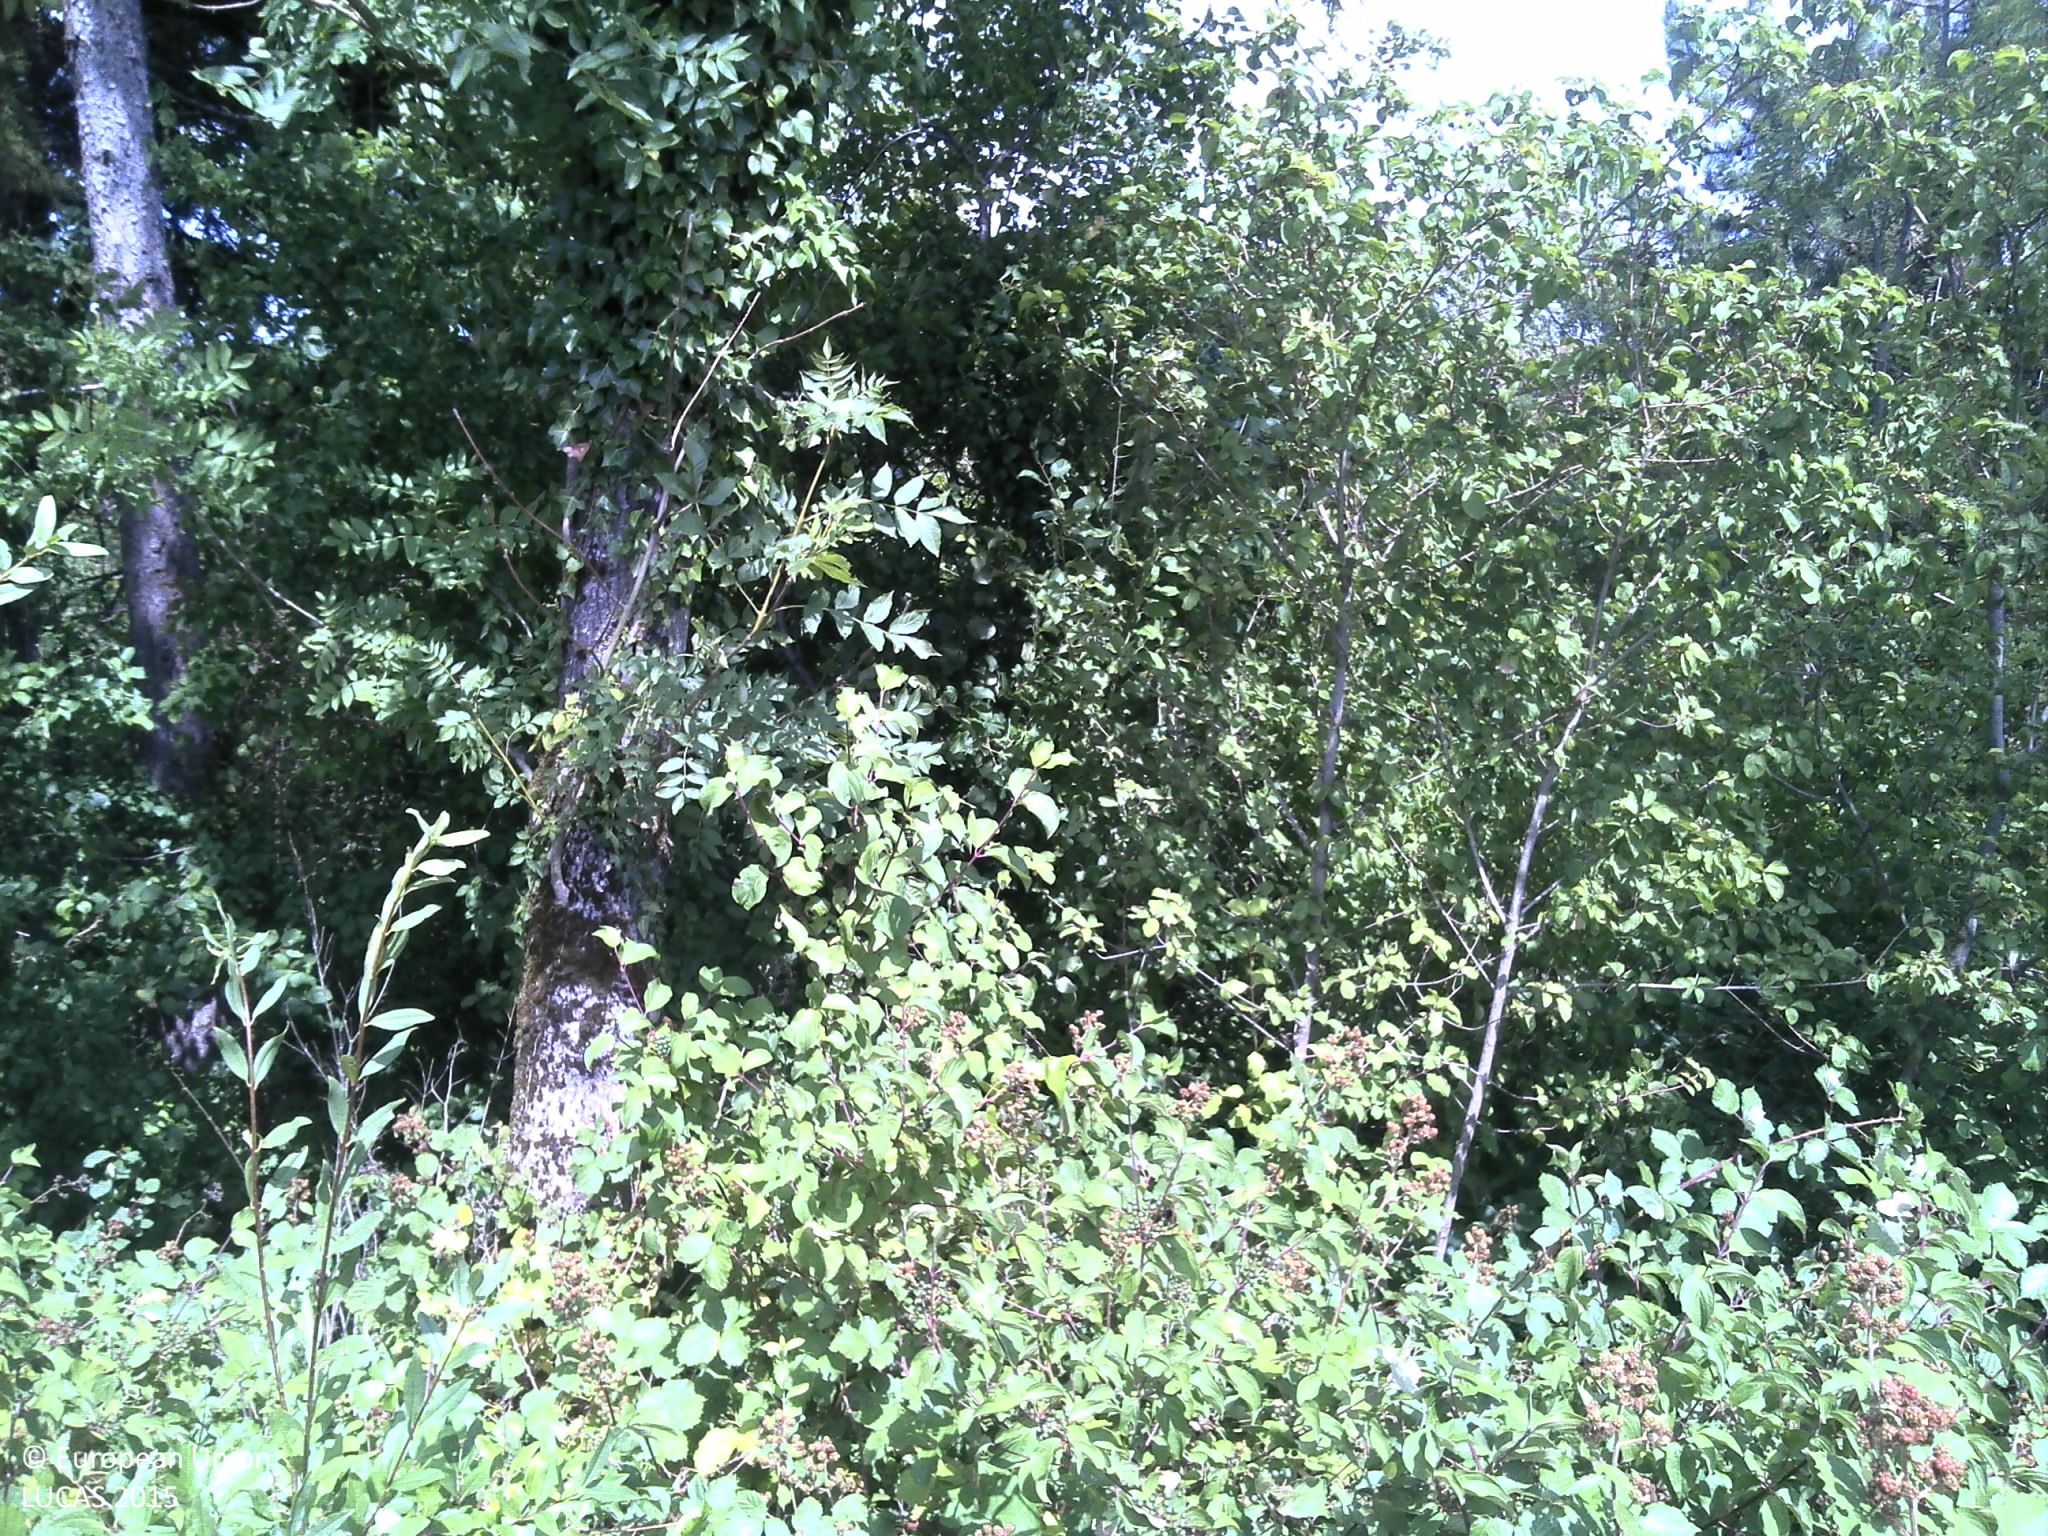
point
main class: Woodland
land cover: Pine dominated mixed woodland
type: alpine coniferous forest
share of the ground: > 75 %
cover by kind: coniferous forest trees 40 %, herbaceous plants 40 %, broadleaved forest trees 20 %
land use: Forestry
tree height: > 5 m
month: July
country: FR
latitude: 49.3195
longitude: 4.6452
